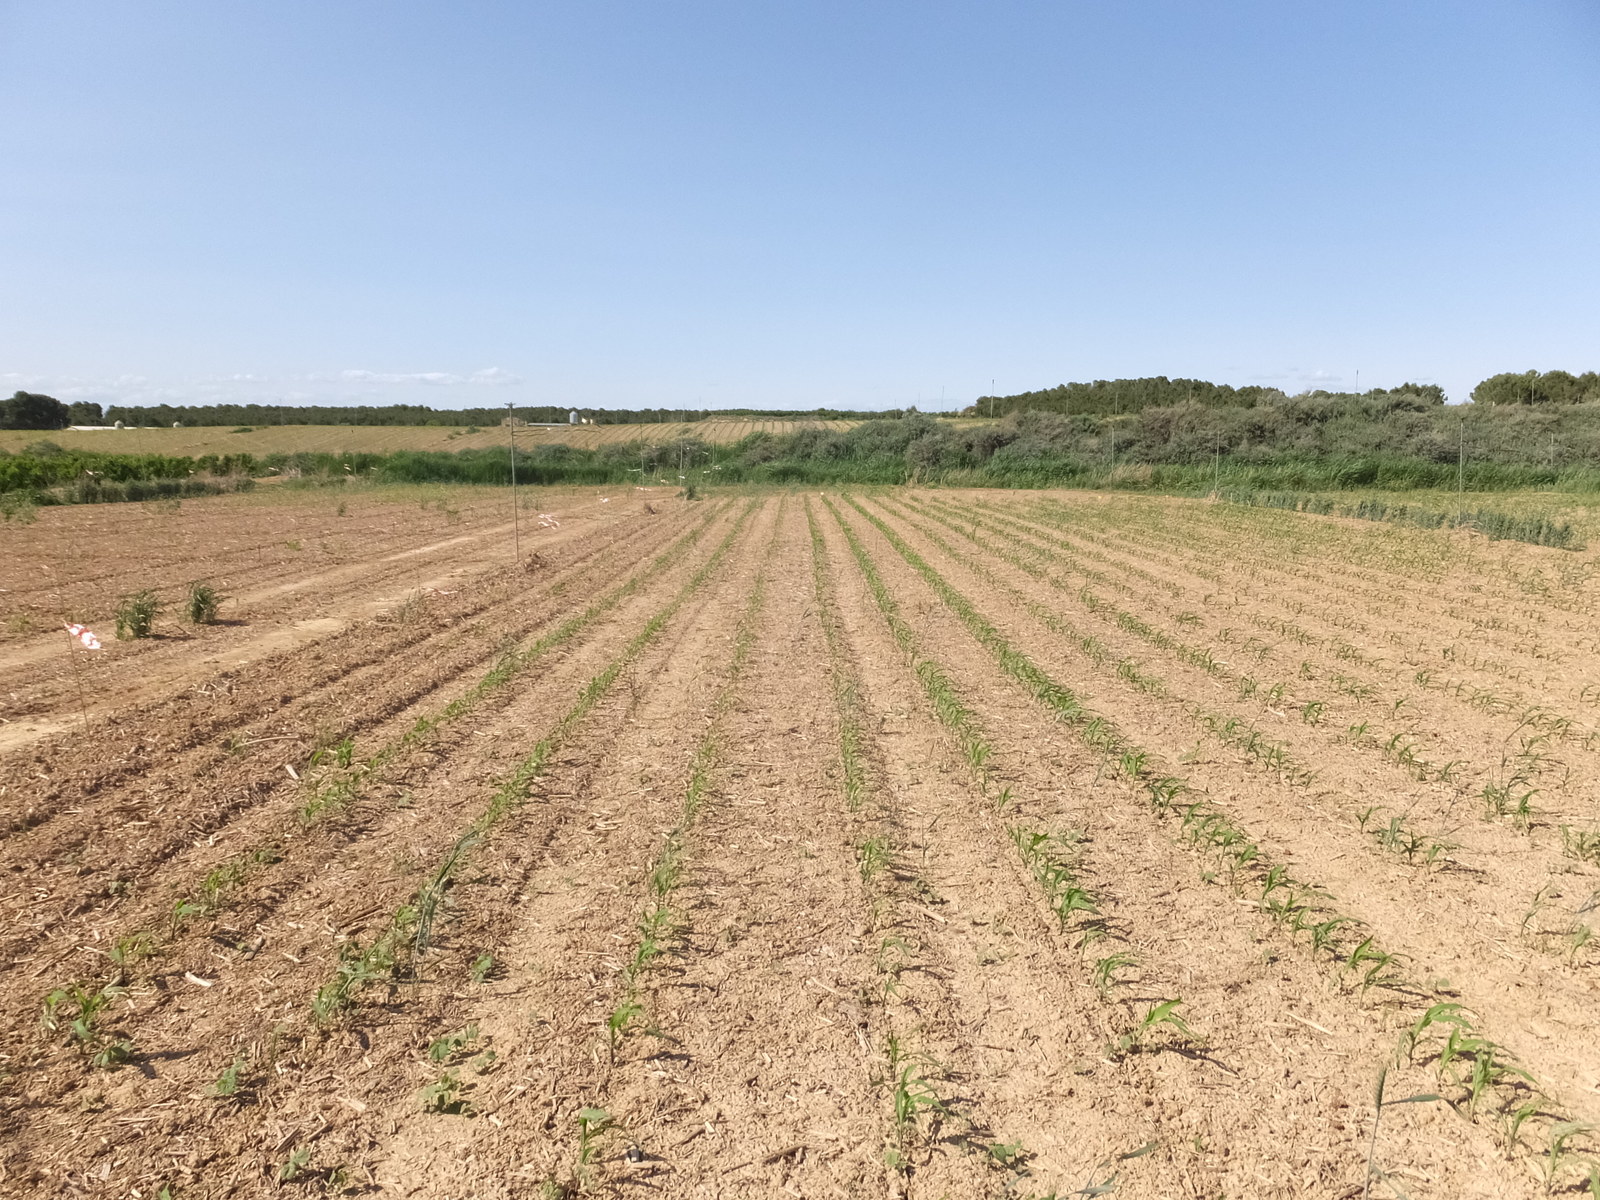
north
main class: Cropland
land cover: Maize
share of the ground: 10 - 25 %
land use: Agriculture (excluding fallow land and kitchen gardens)
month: May
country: ES
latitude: 41.6642
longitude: 0.3420
